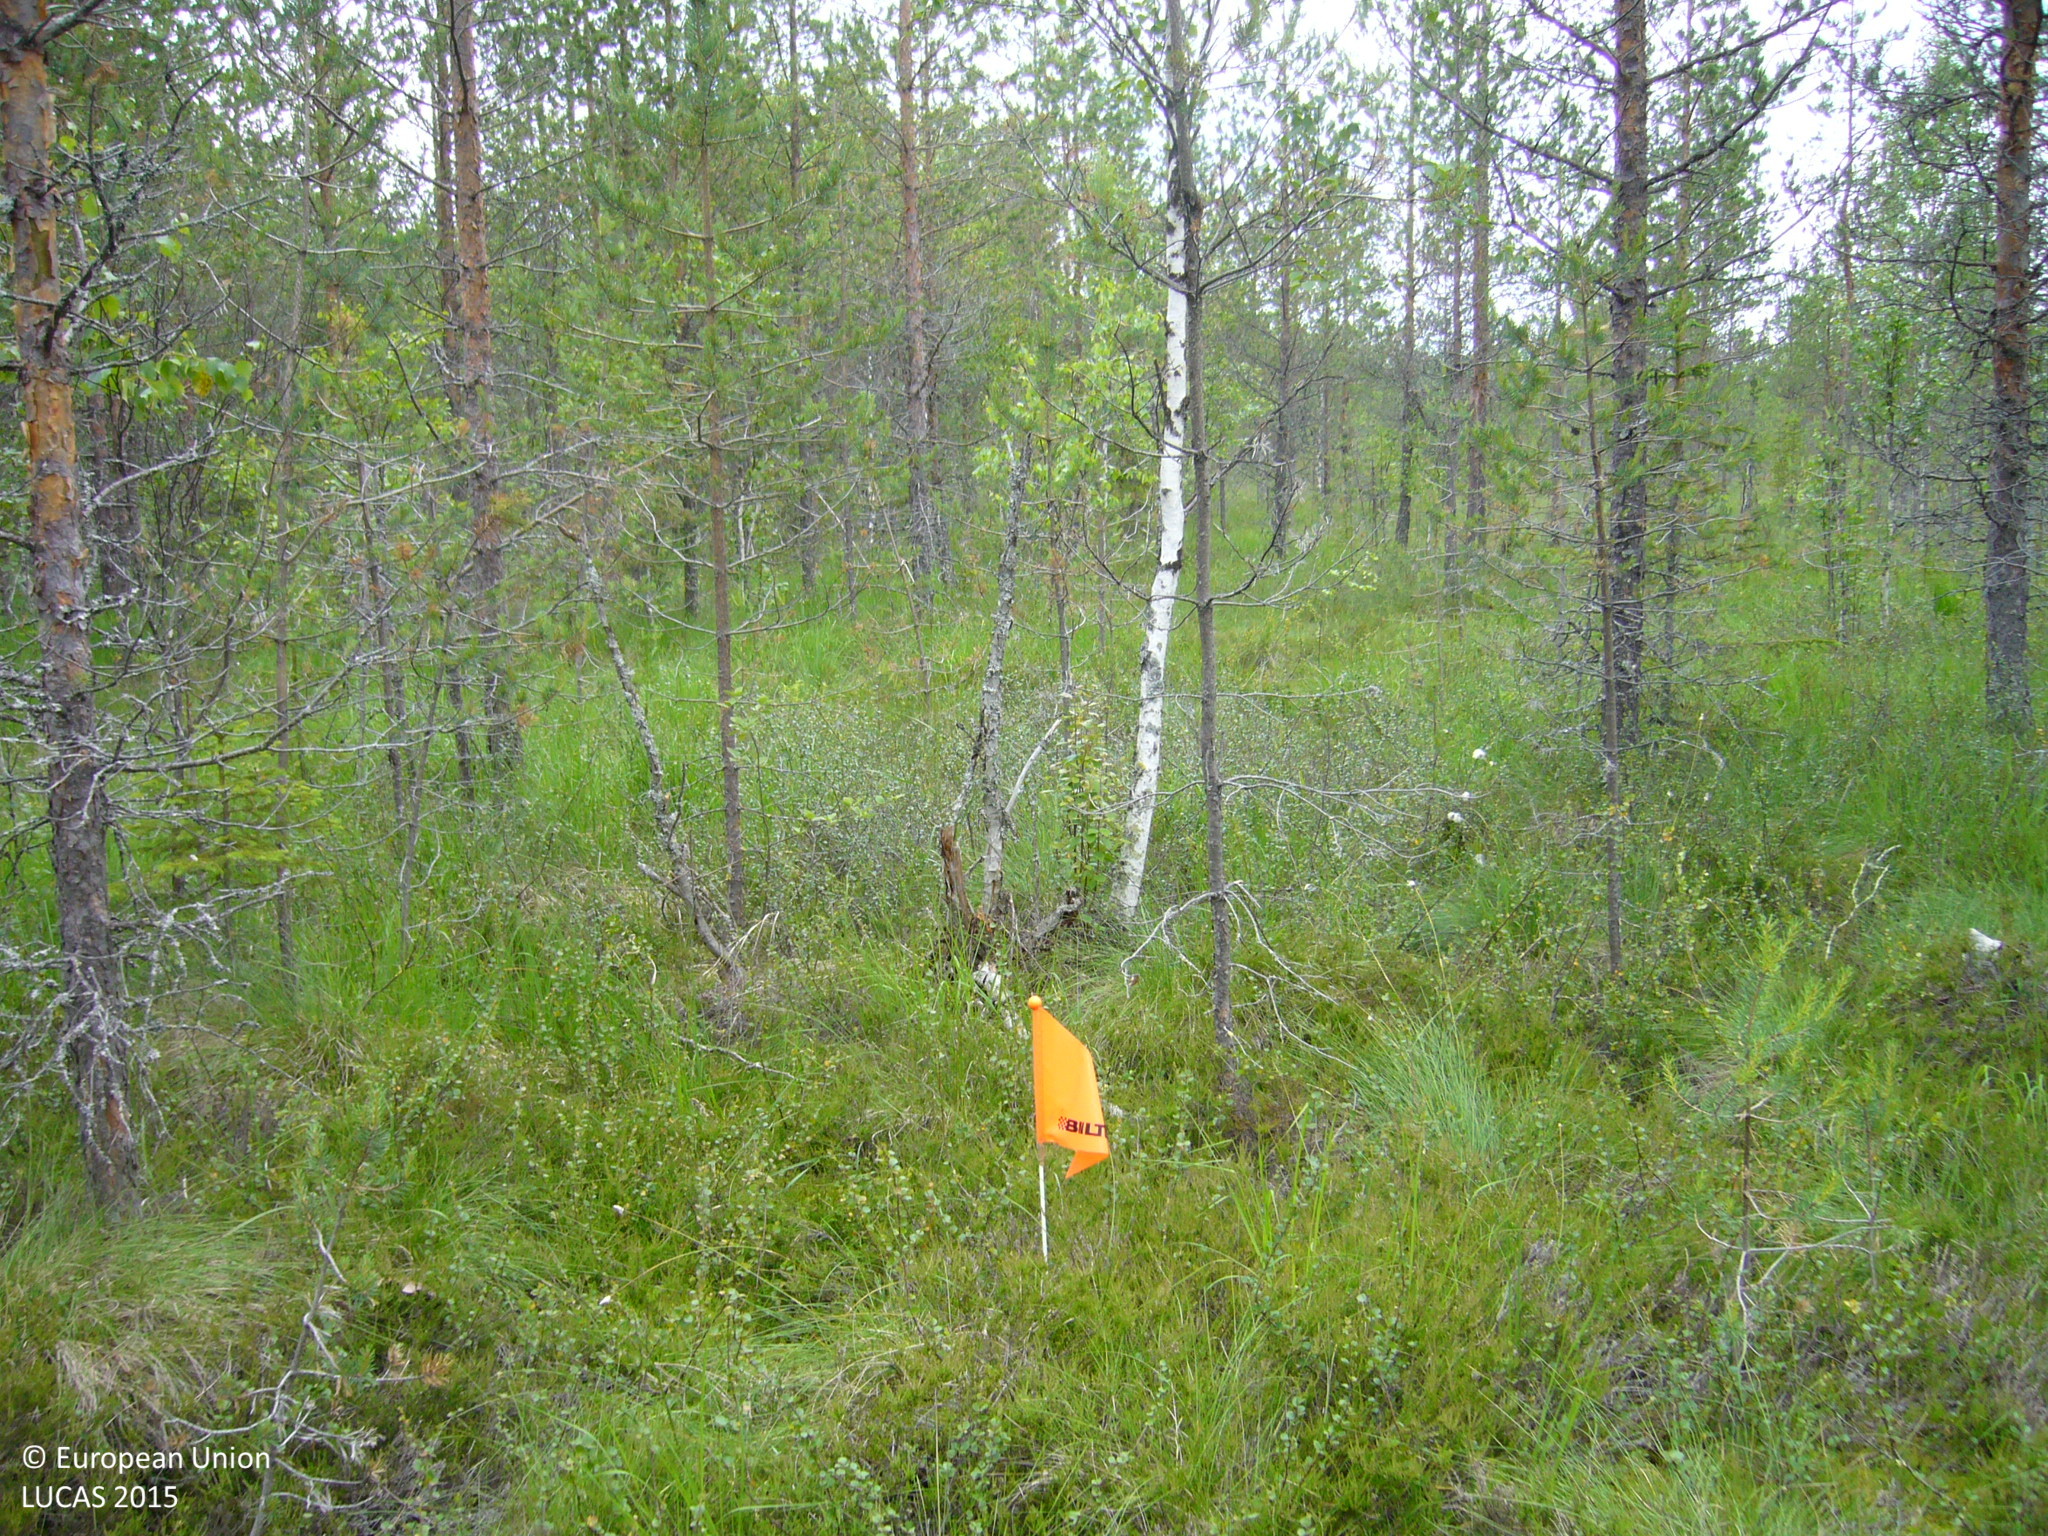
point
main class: Woodland
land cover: Pine dominated coniferous woodland
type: mire and swamp forests
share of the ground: 25 - 50 %
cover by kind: shrubs 60 %, coniferous forest trees 30 %, broadleaved forest trees 10 %
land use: Forestry
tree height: > 5 m
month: July
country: FI
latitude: 63.7797
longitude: 25.6617
